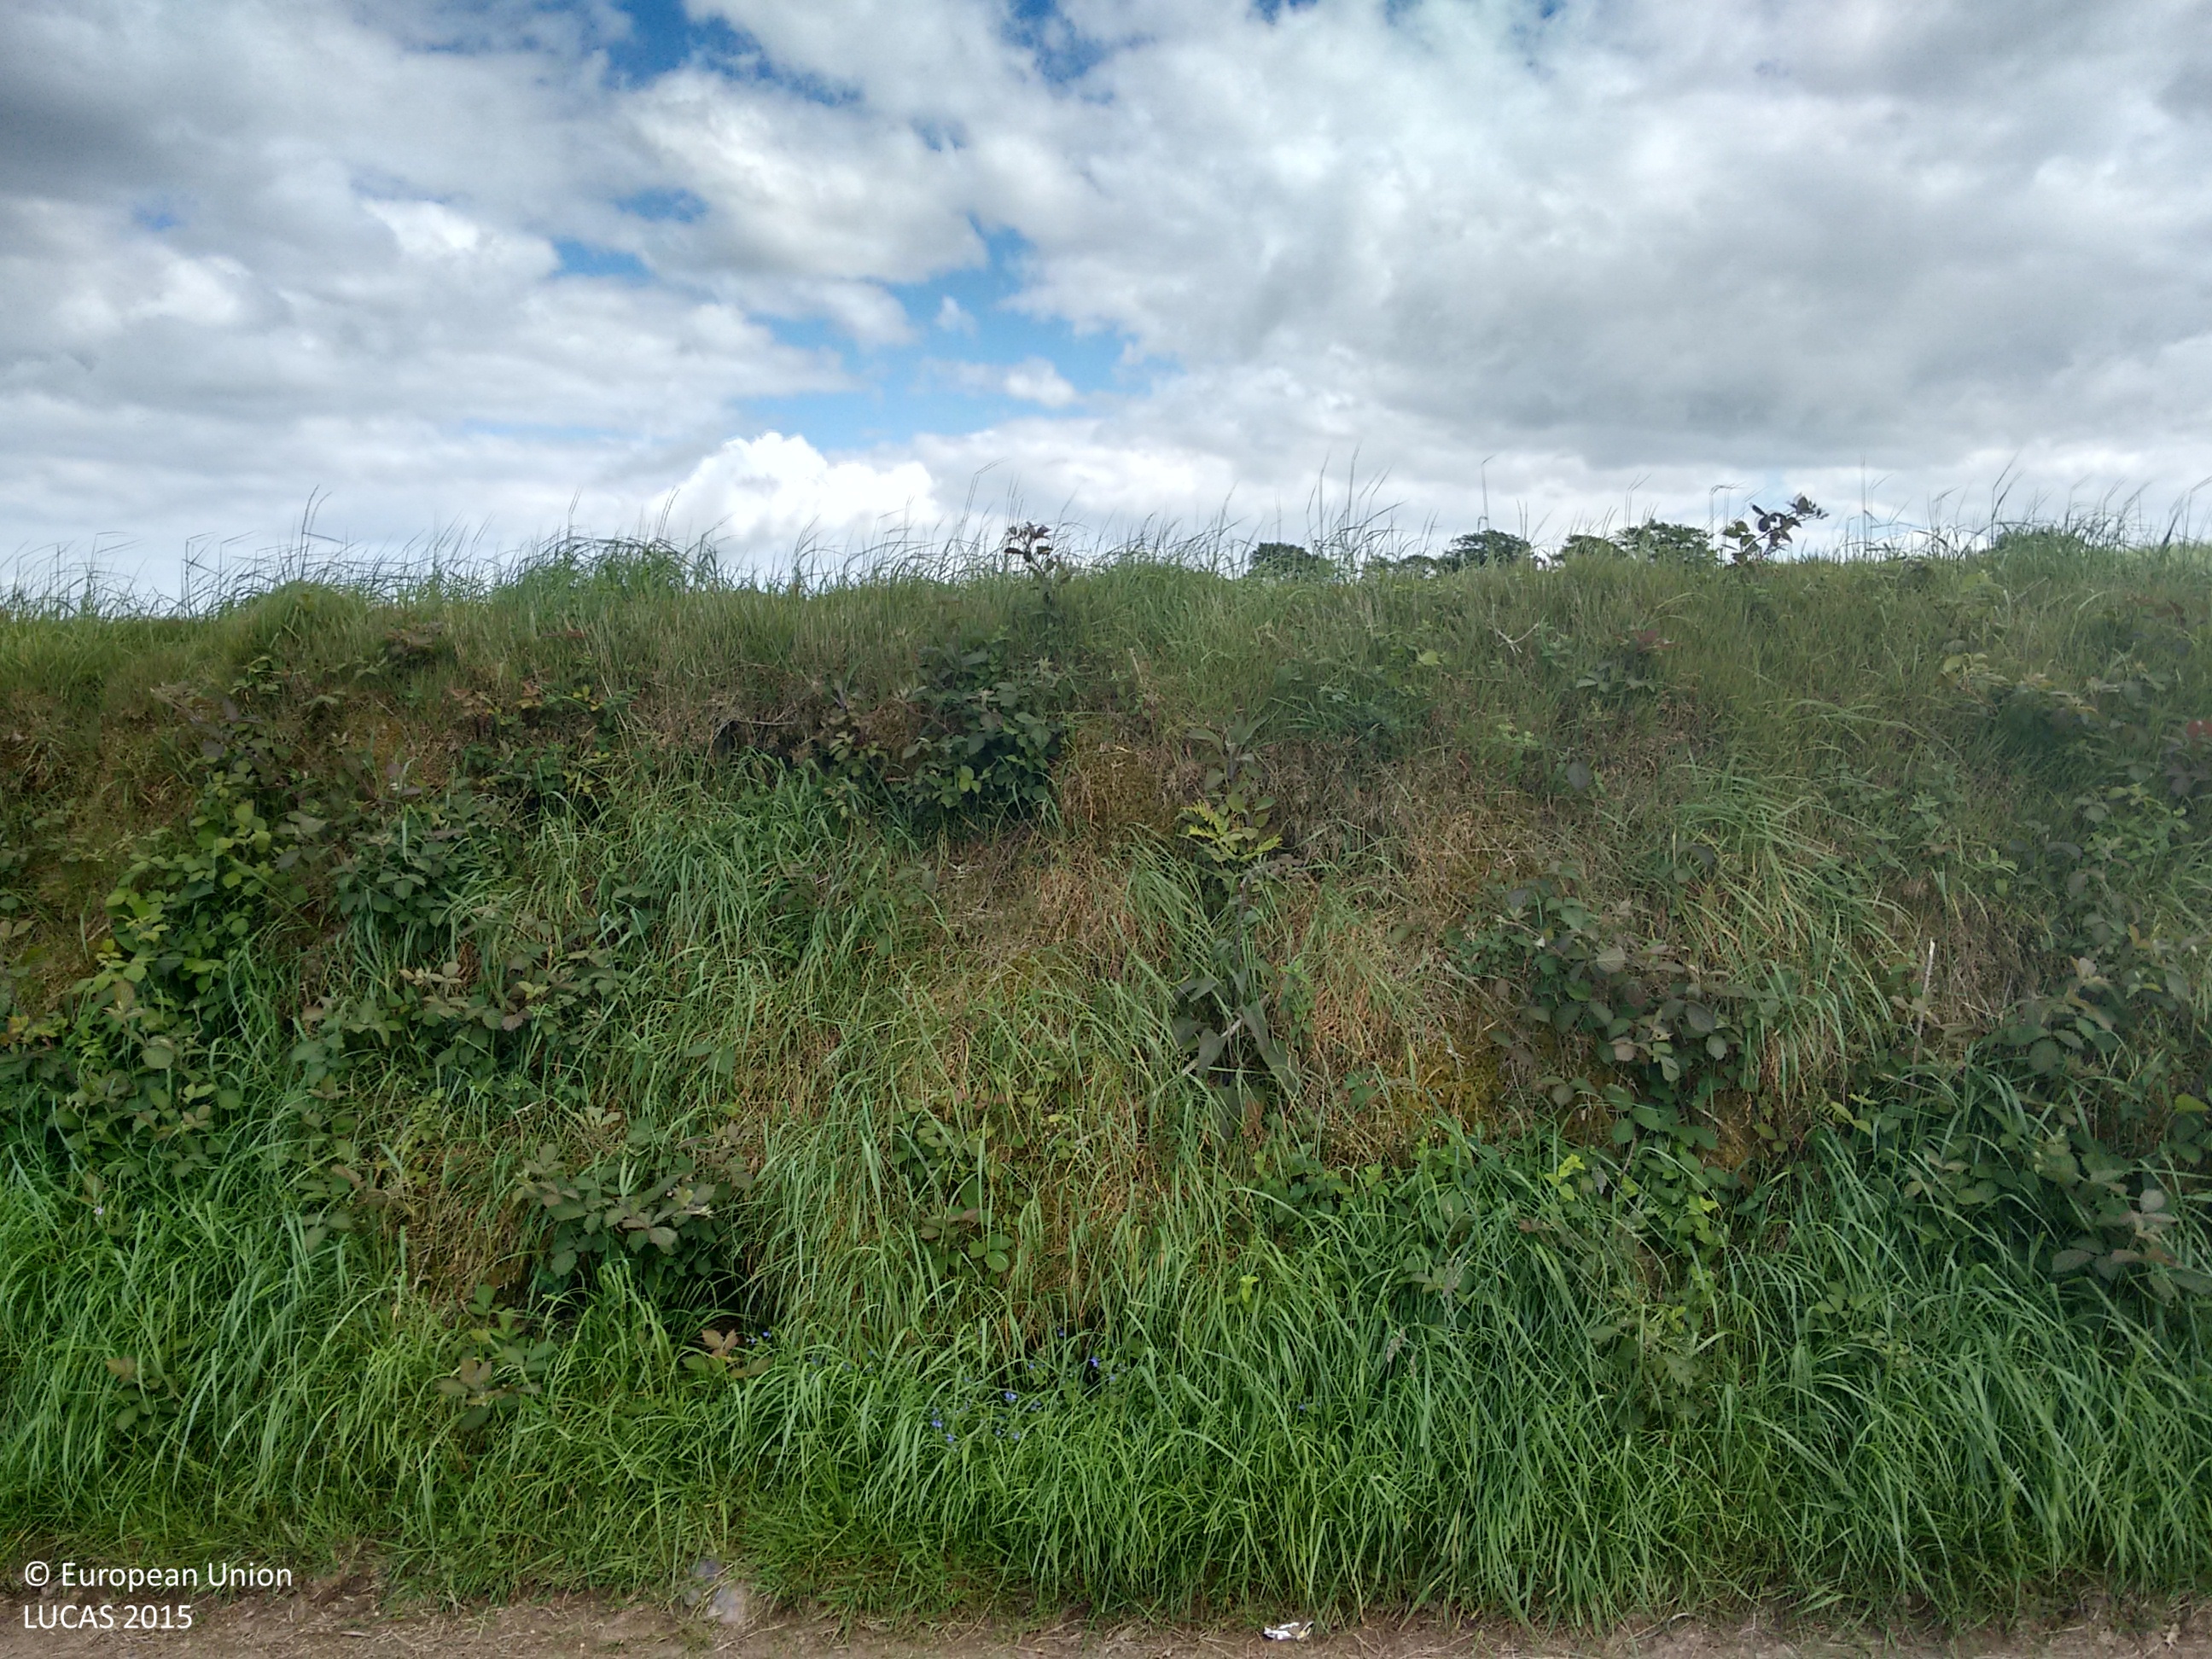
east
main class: Cropland
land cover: Barley
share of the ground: > 75 %
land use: Agriculture (excluding fallow land and kitchen gardens)
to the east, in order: Barley; Abandoned hedges; Electric lines; Tracks; Abandoned hedges; Barley
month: June
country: IE
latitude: 51.9440
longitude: -8.1174
